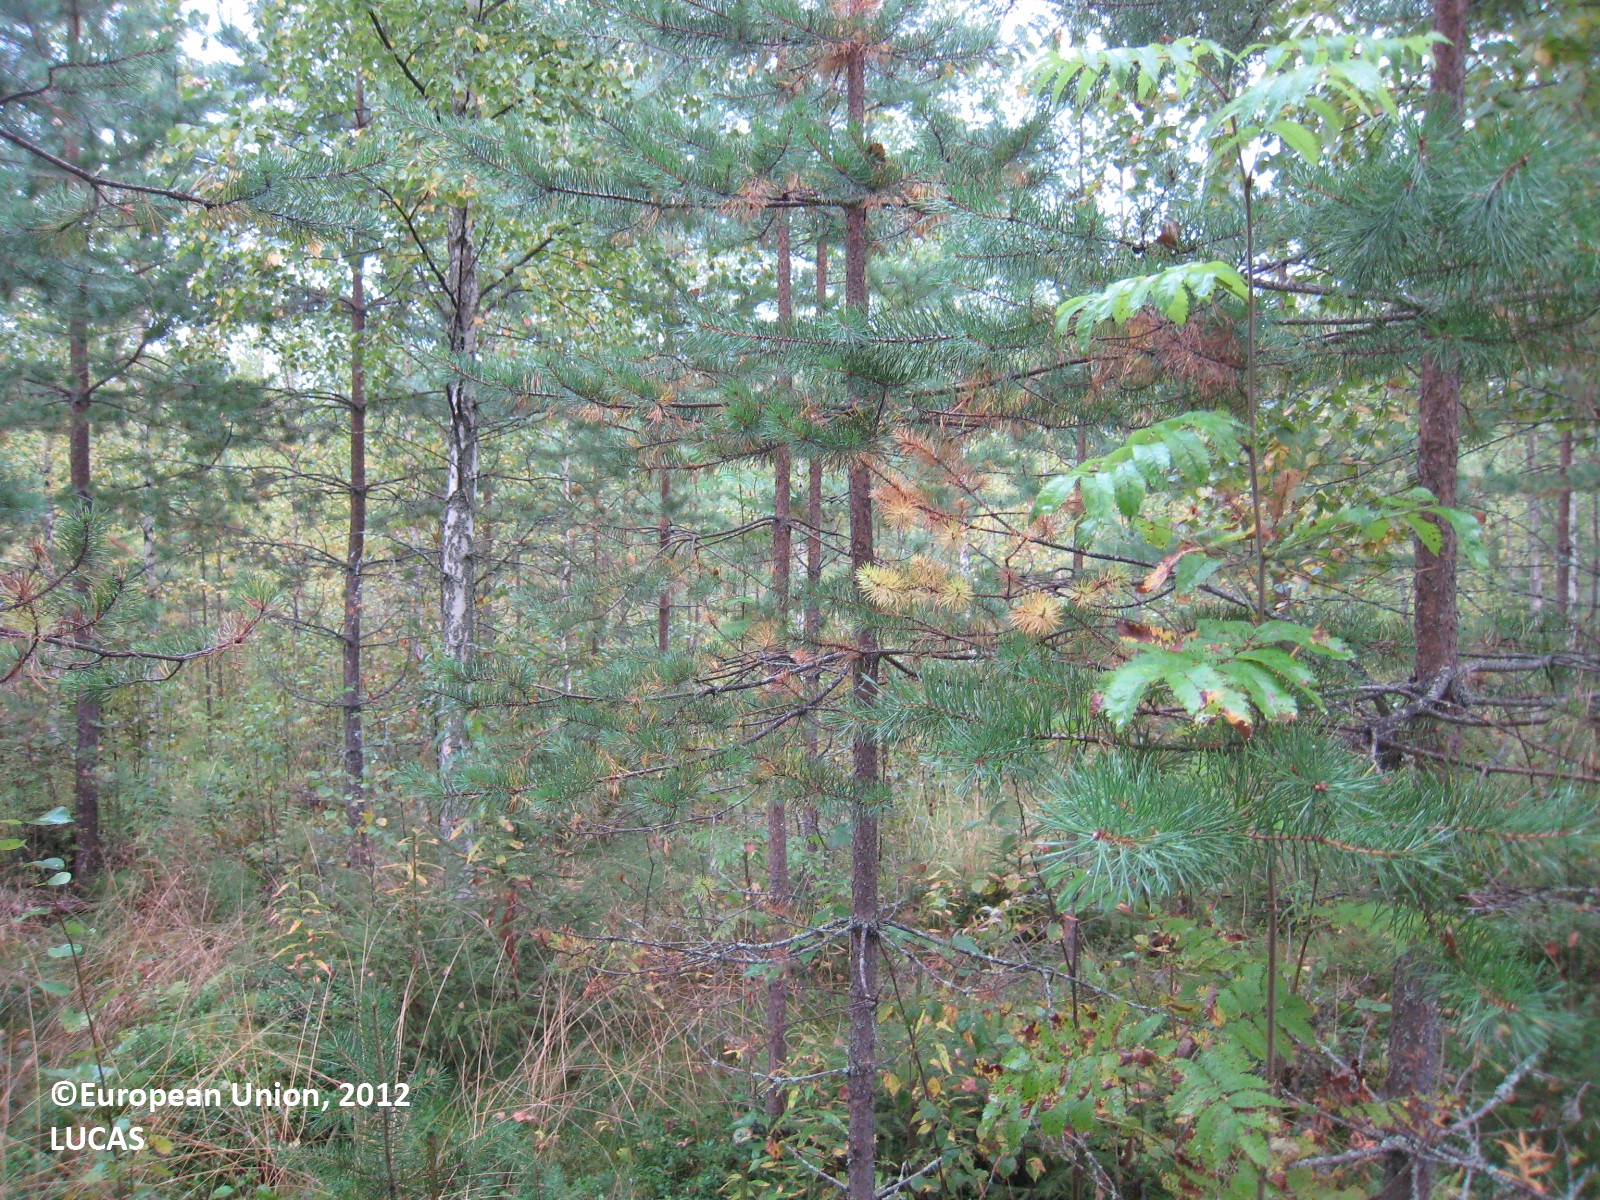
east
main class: Woodland
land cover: Pine dominated mixed woodland
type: boreal forest
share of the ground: > 75 %
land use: Forestry
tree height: > 5 m
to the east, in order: Pine dominated mixed woodland; Pine dominated coniferous woodland; Grassland with sparse tree/shrub cover
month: August
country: FI
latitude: 62.1459
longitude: 27.2182
